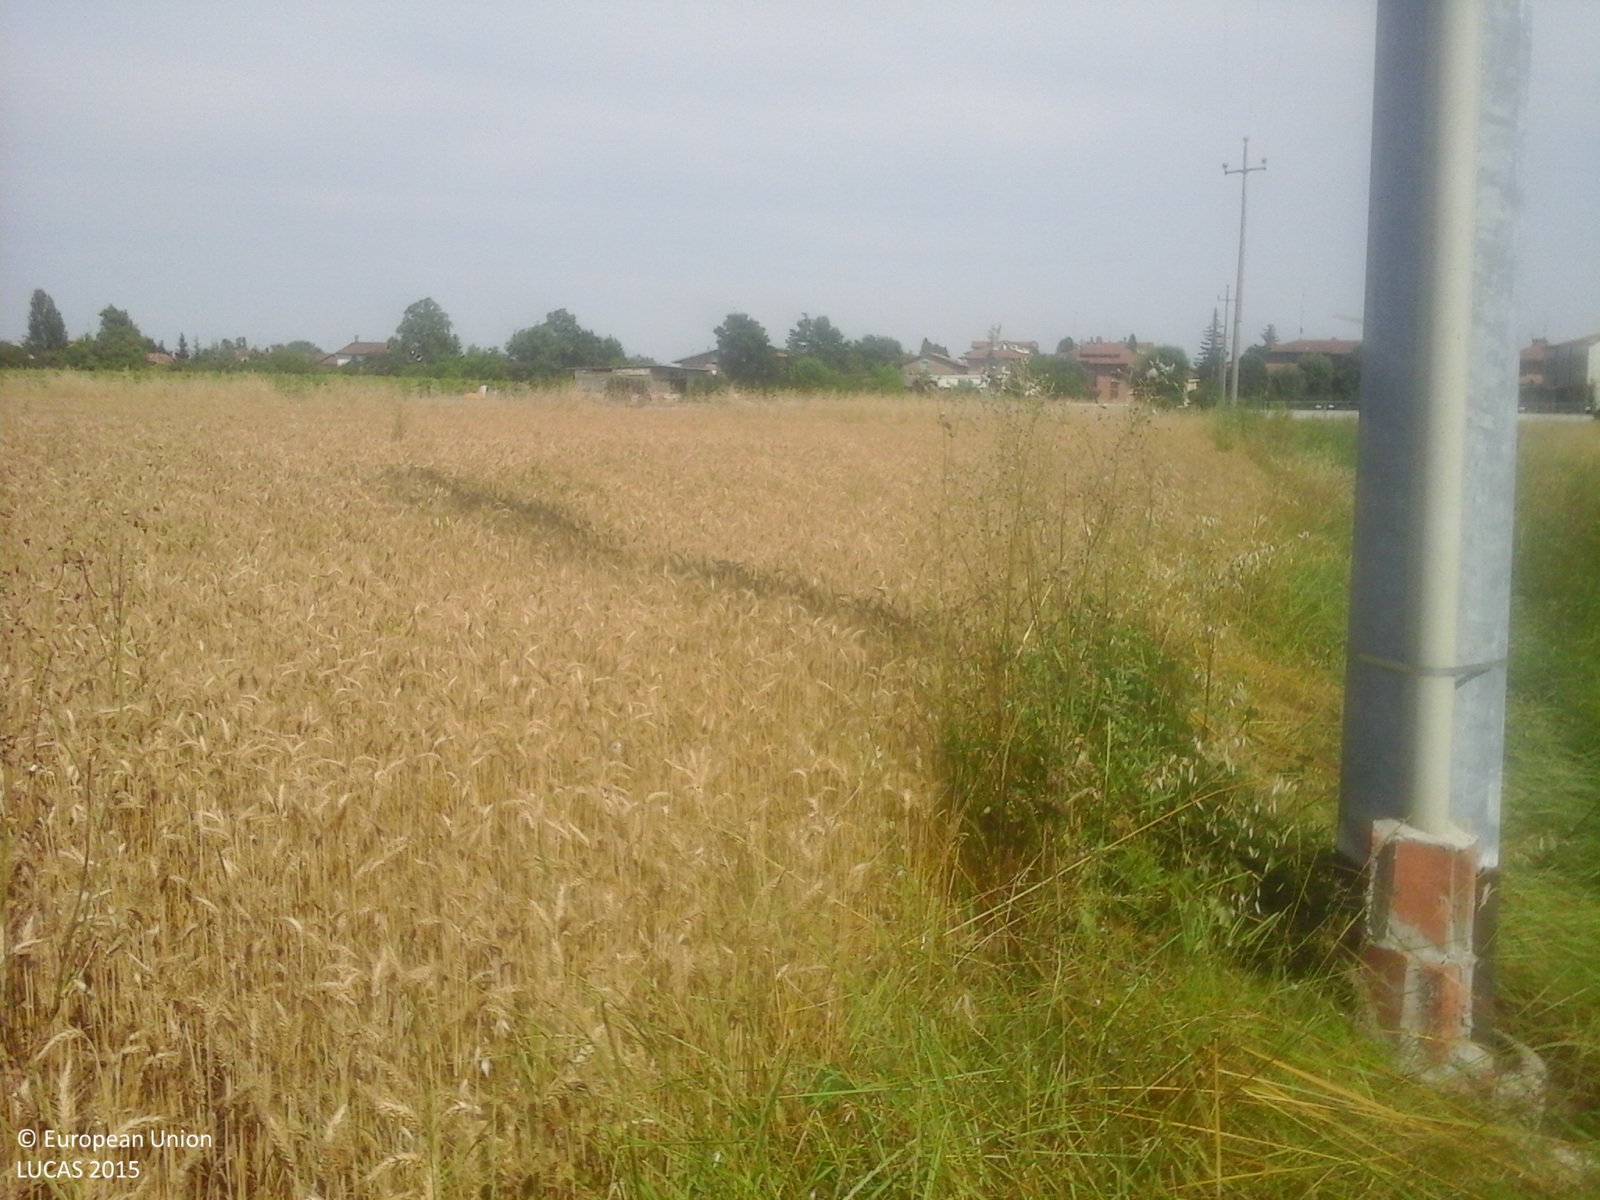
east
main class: Cropland
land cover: Common wheat
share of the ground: > 75 %
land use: Agriculture (excluding fallow land and kitchen gardens)
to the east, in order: Common wheat; Ditches and canals; Common wheat; Ditches and canals; Common wheat; Ditches and canals; Common wheat; Ditches and canals; Common wheat; Ditches and canals; Artificial constructions in urban areas; Other fruit trees and berries; Artificial constructions in urban areas
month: June
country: IT
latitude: 44.6880
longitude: 11.0451
